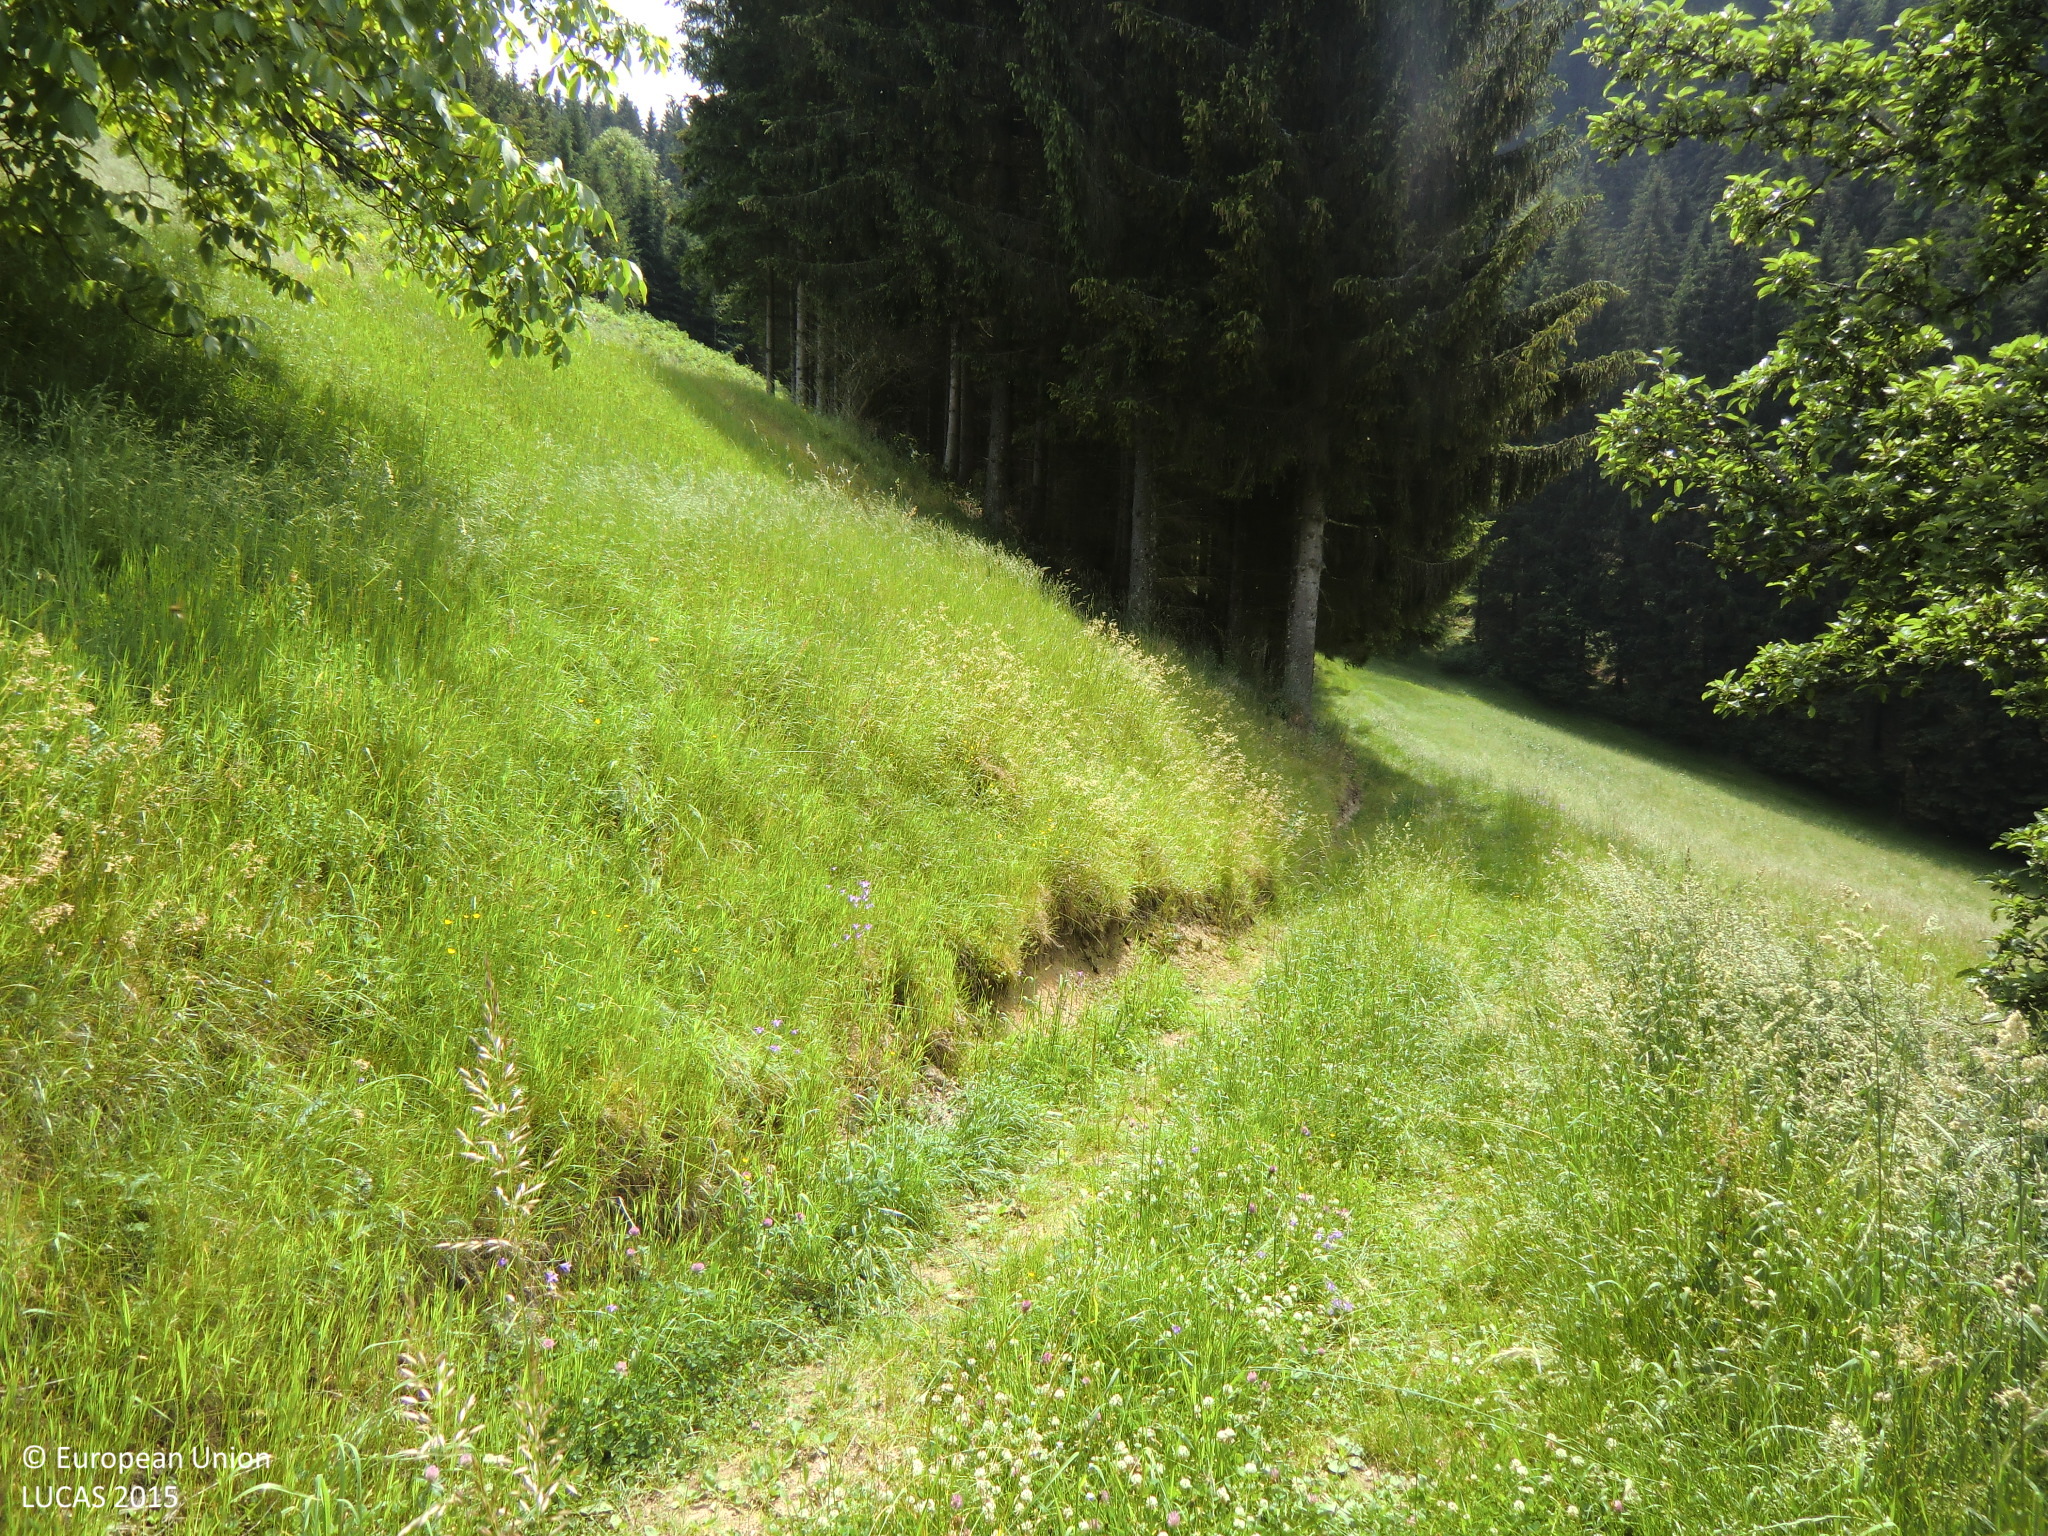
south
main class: Cropland
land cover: Apple fruit
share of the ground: 25 - 50 %
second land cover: Grassland without tree/shrub cover
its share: > 75 %
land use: Agriculture (excluding fallow land and kitchen gardens)
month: June
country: AT
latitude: 48.3717
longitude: 14.7934
